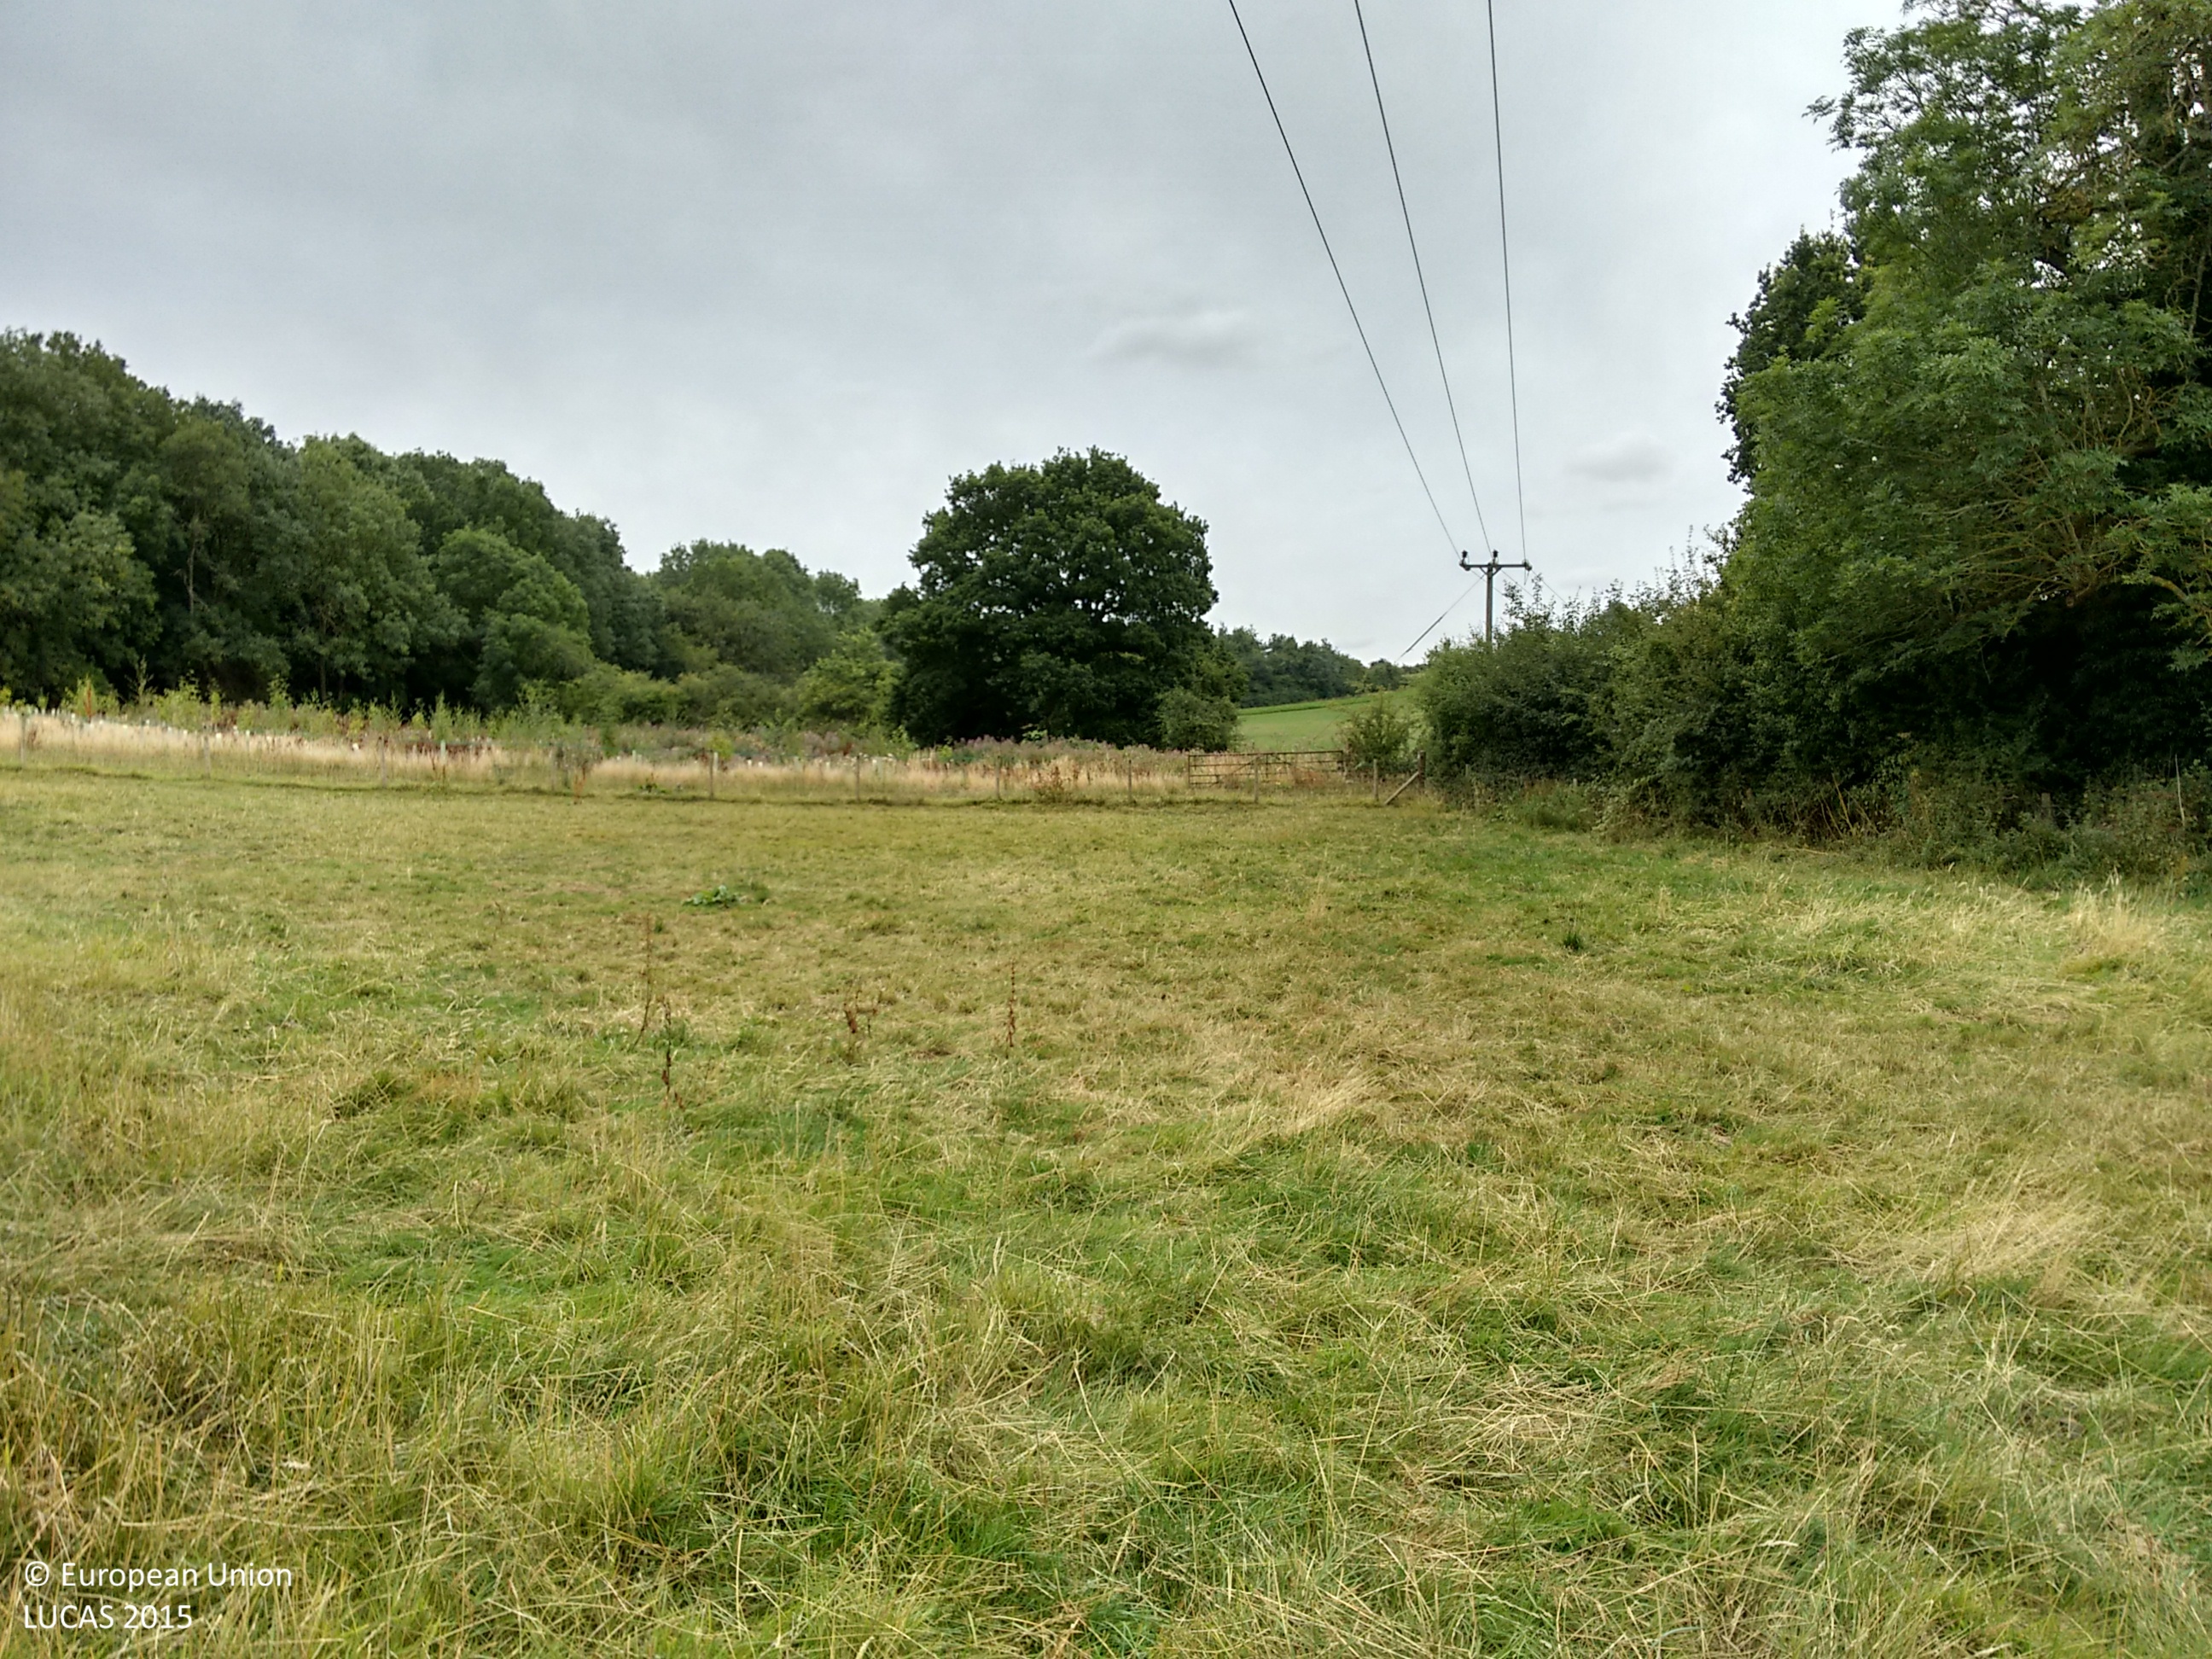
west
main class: Grassland
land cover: Grassland without tree/shrub cover
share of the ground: > 75 %
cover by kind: herbaceous plants 100 %
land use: Agriculture (excluding fallow land and kitchen gardens)
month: August
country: GB
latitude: 52.1161
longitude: -1.2191
